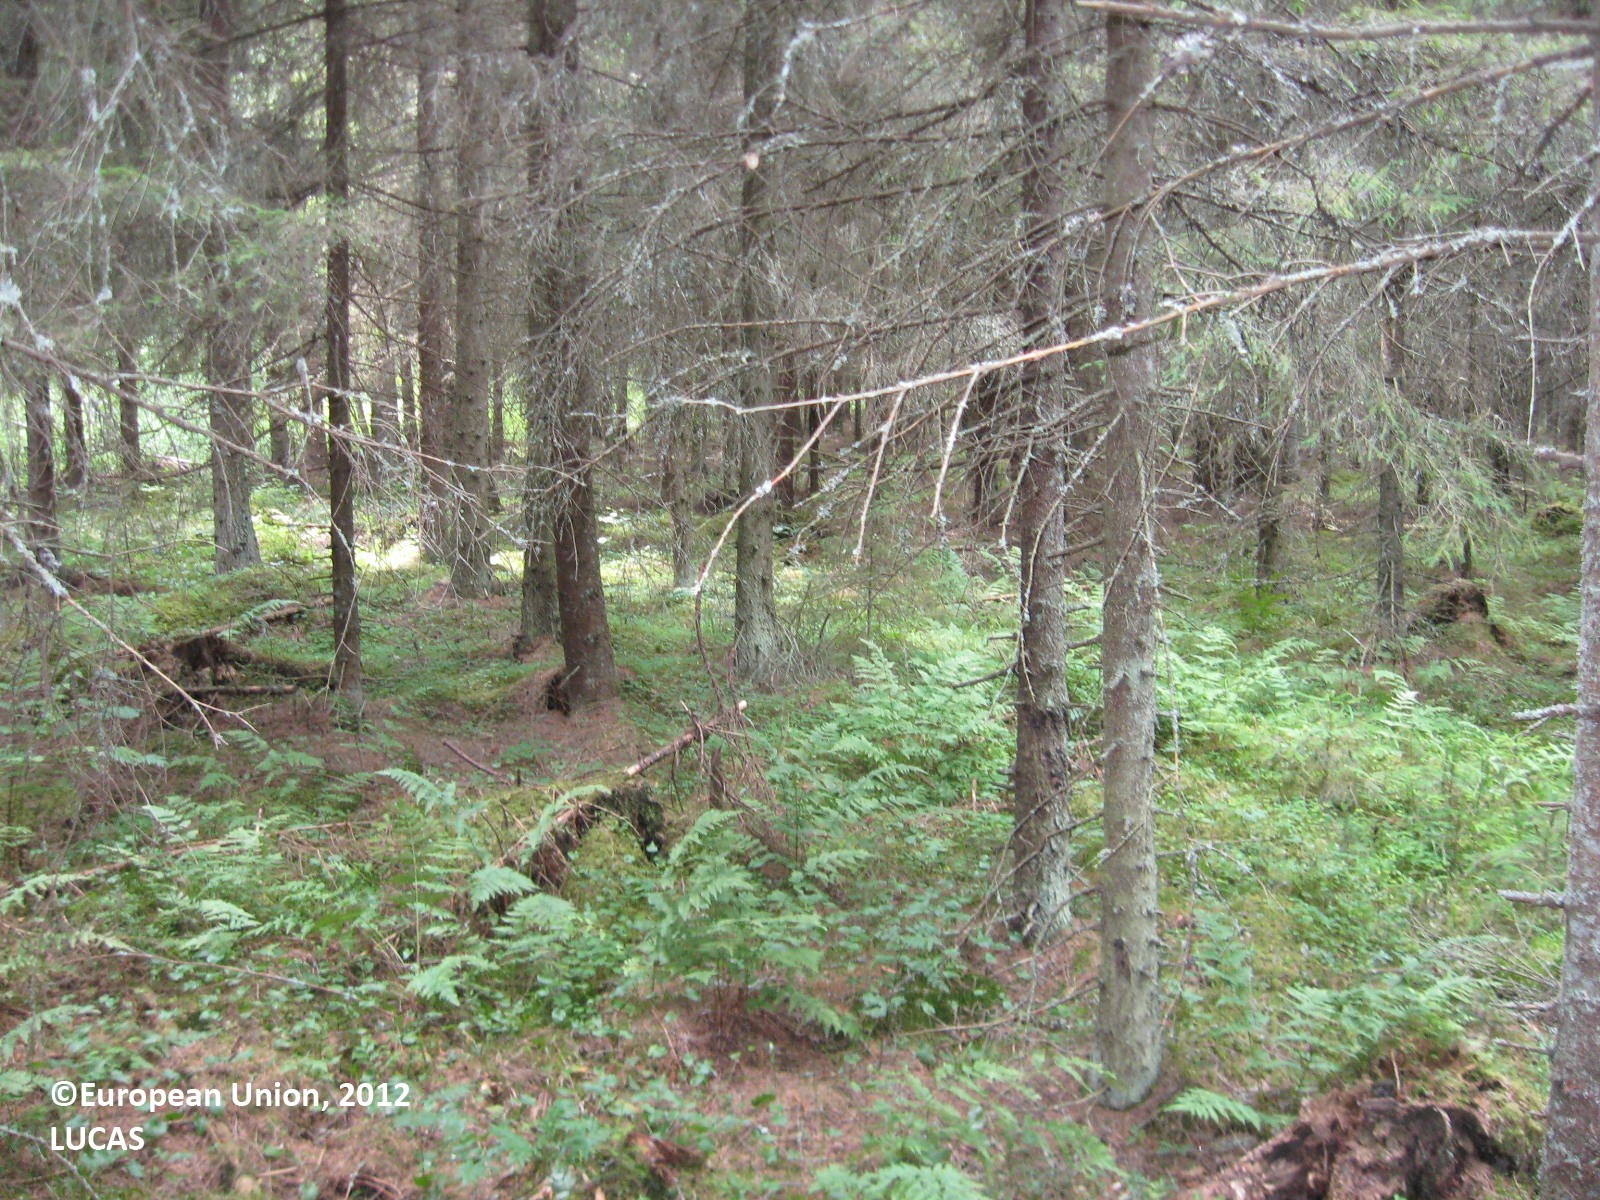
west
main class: Woodland
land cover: Spruce dominated coniferous woodland
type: boreal forest
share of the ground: > 75 %
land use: Forestry
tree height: > 5 m
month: July
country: FI
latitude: 62.4297
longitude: 21.4505
